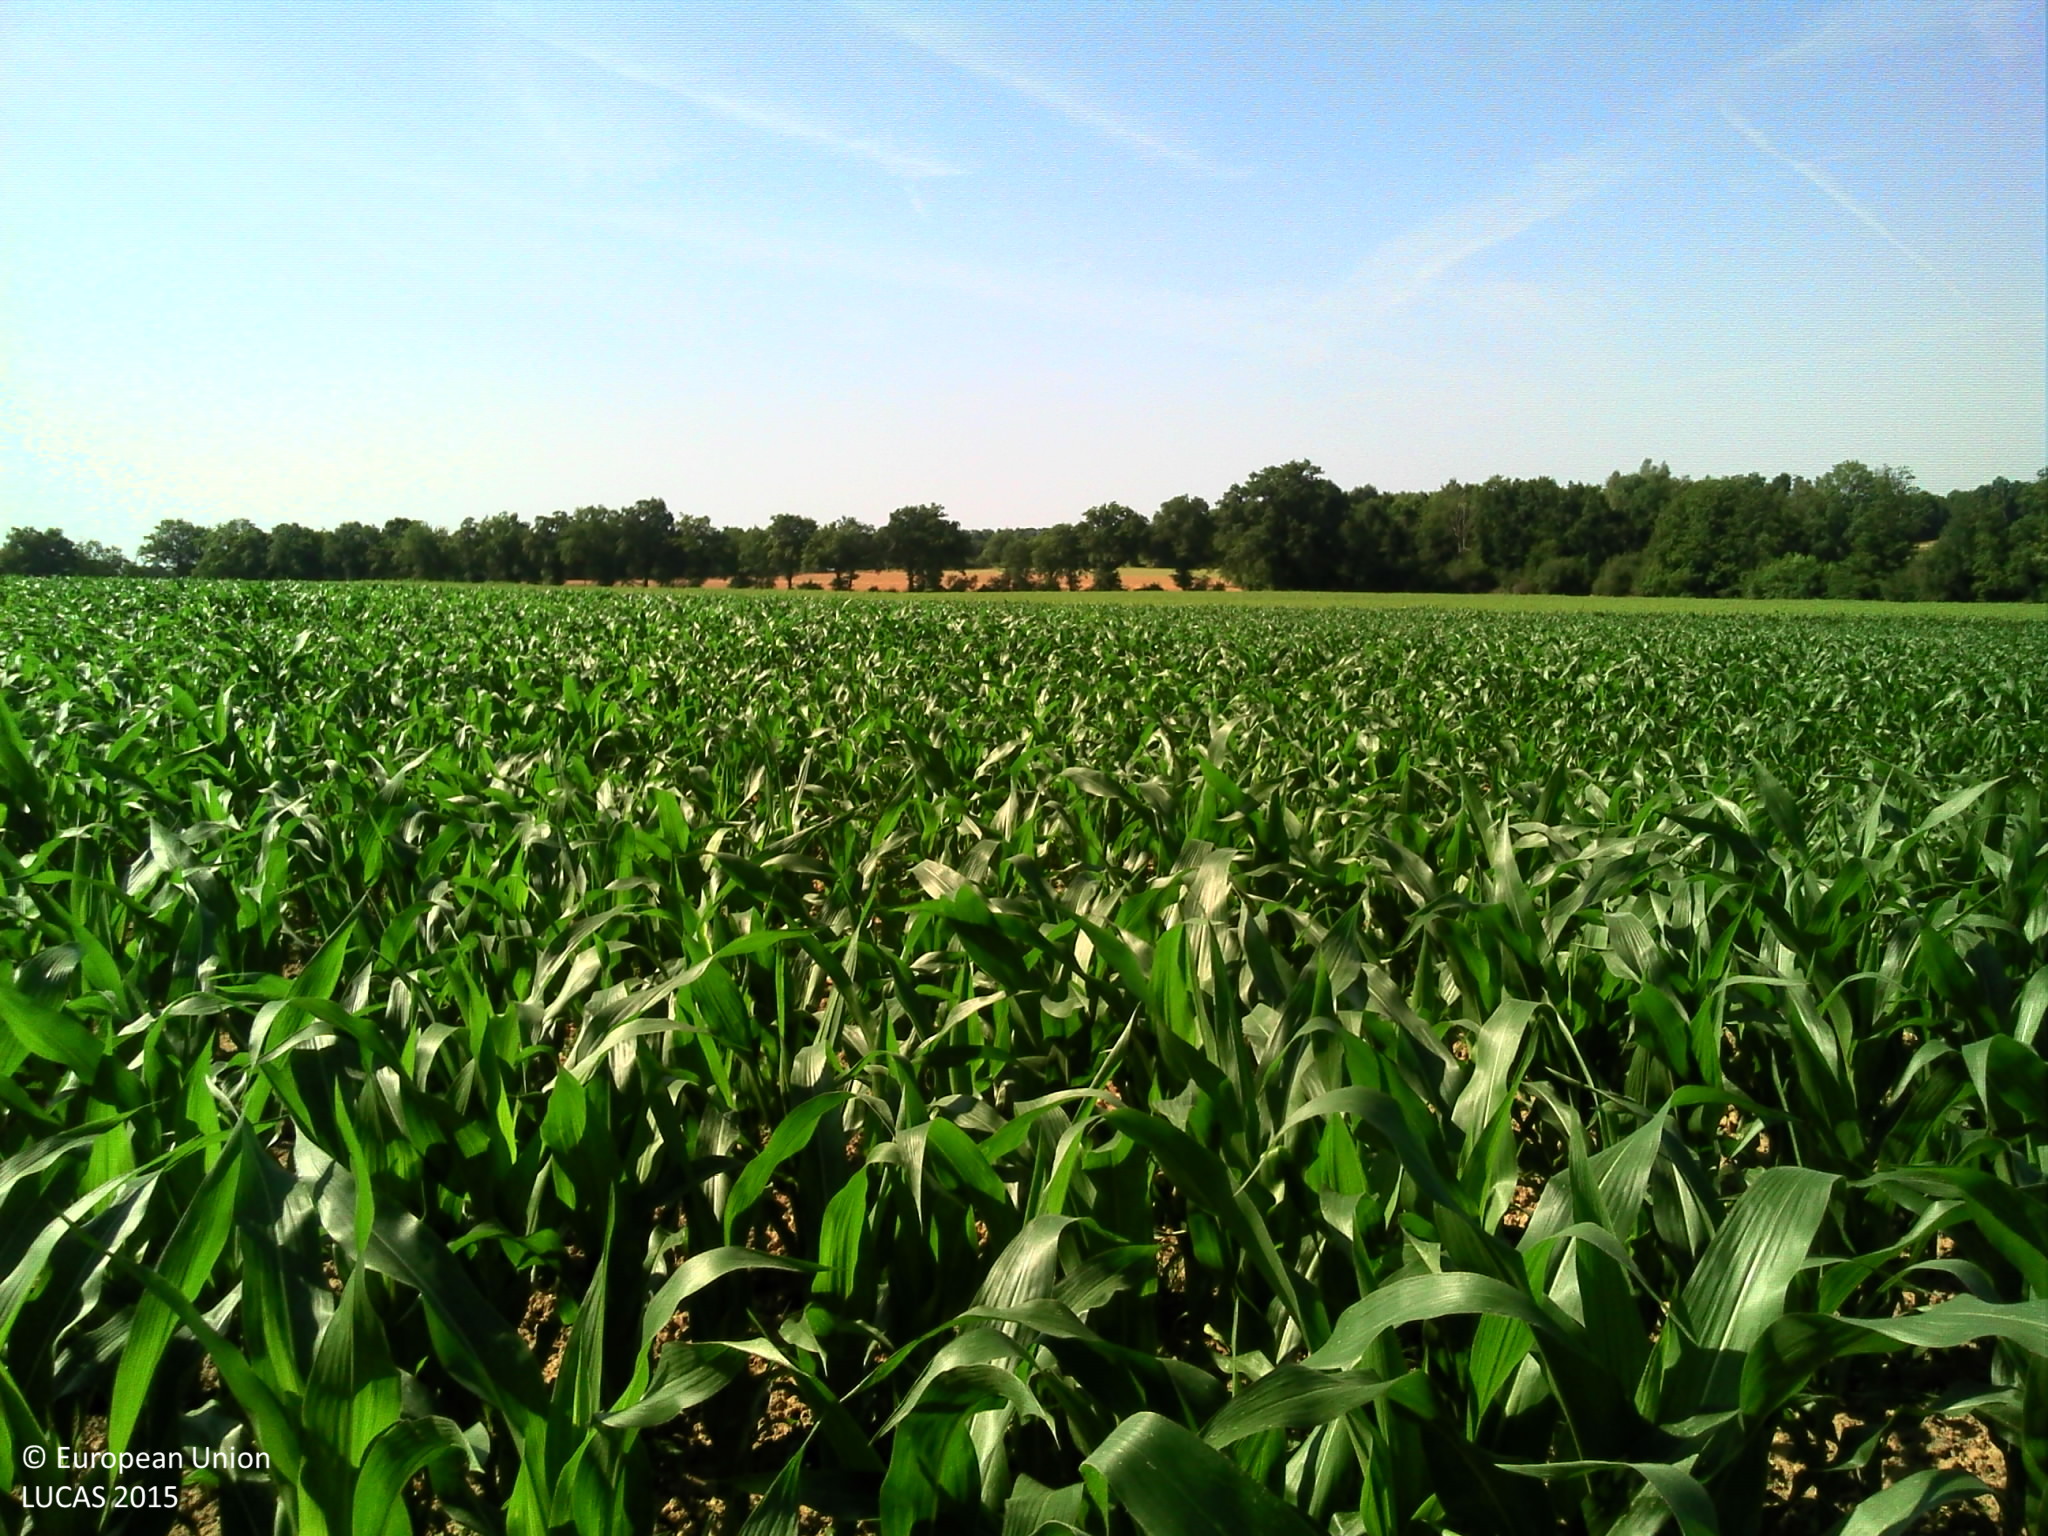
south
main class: Cropland
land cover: Maize
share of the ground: > 75 %
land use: Agriculture (excluding fallow land and kitchen gardens)
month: July
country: FR
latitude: 46.3078
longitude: 0.9103
